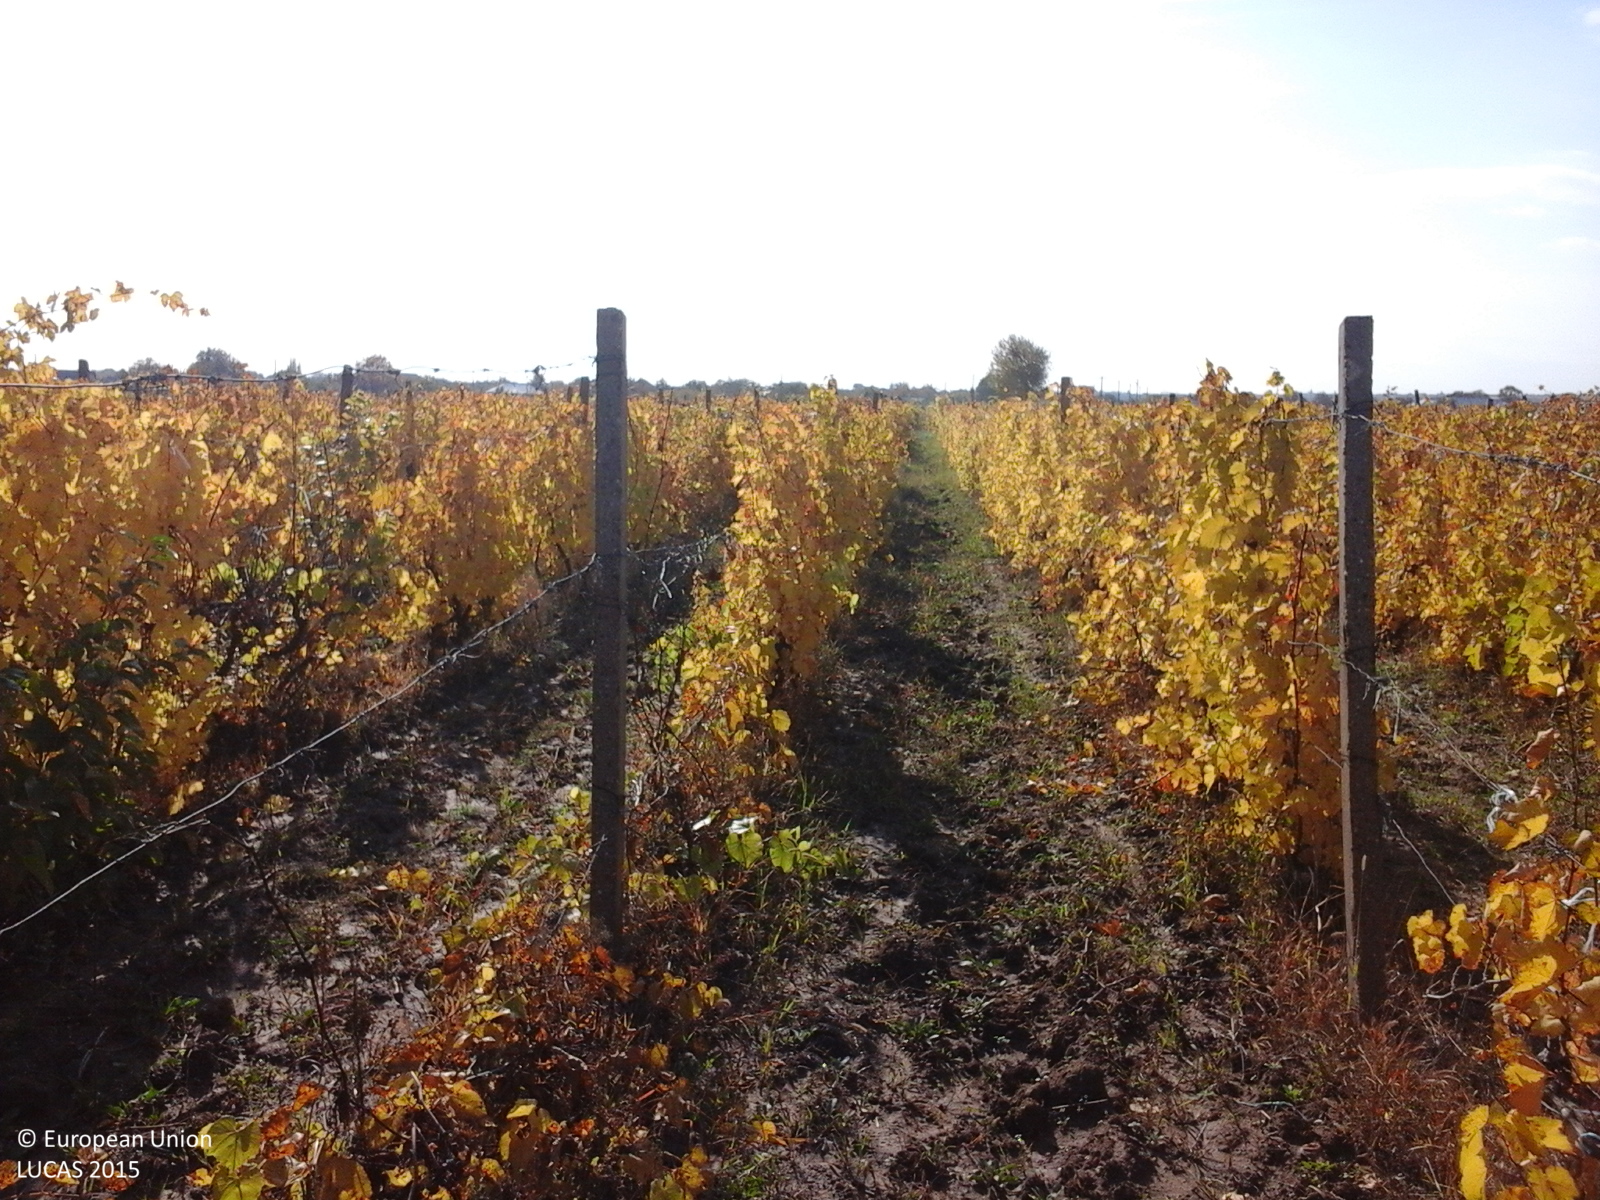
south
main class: Cropland
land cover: Vineyards
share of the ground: > 75 %
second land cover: Other bare soil
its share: > 75 %
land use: Agriculture (excluding fallow land and kitchen gardens)
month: October
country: RO
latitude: 45.5690
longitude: 27.0944
